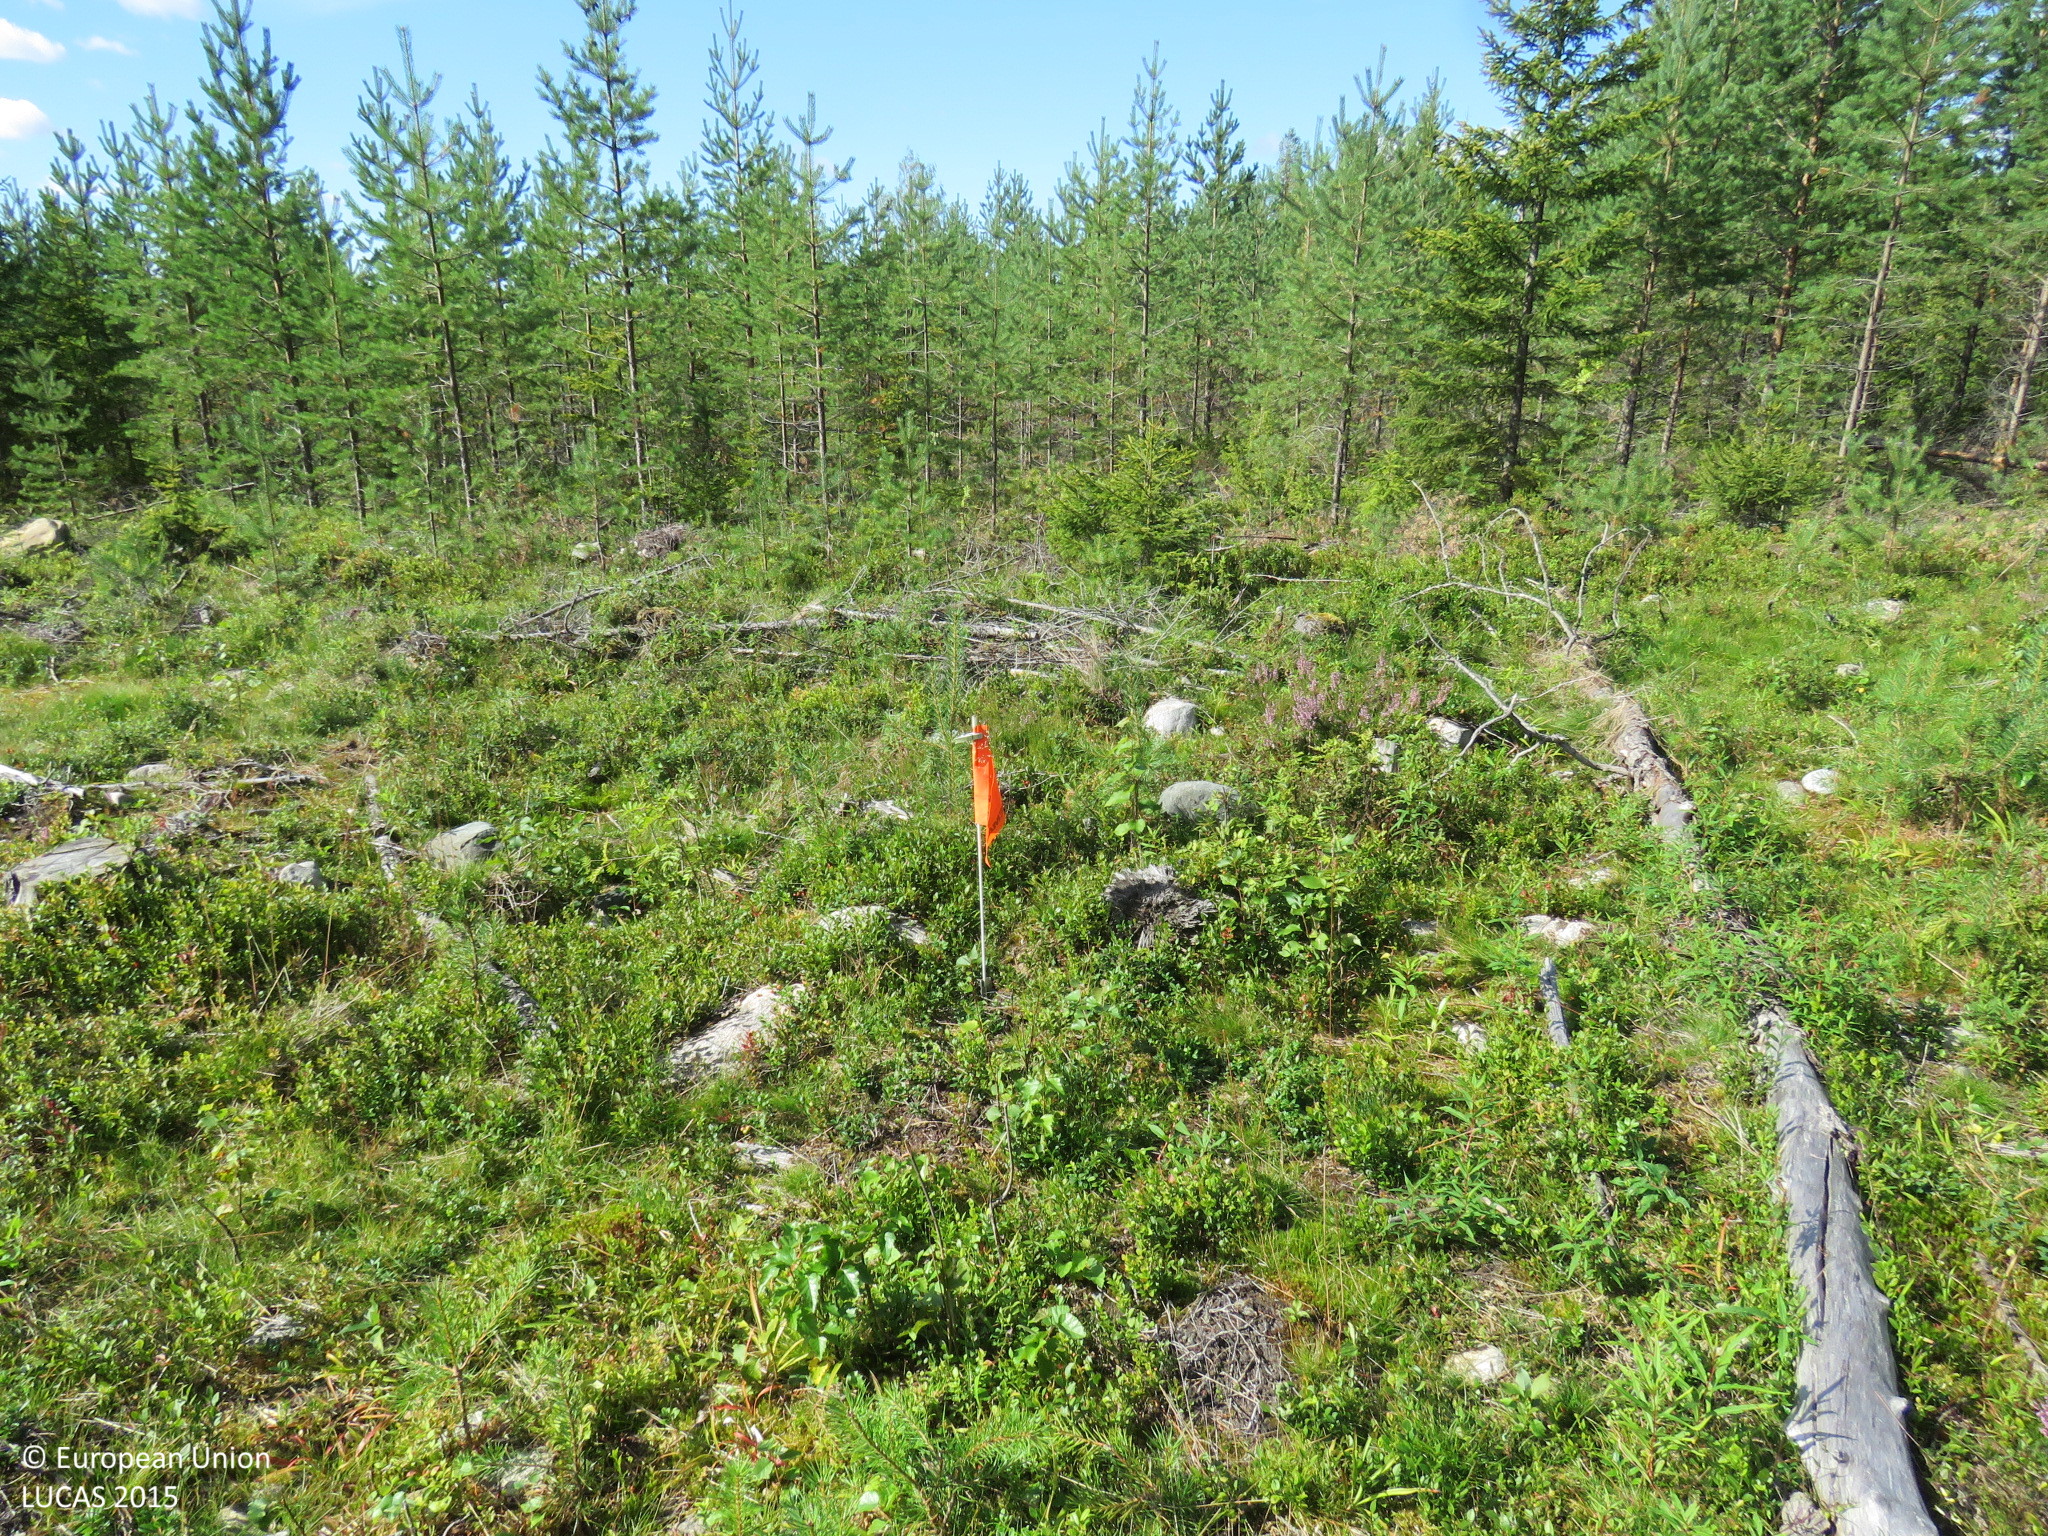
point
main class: Woodland
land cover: Other mixed woodland
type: boreal forest
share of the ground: 25 - 50 %
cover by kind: shrubs 40 %, coniferous forest trees 20 %, herbaceous plants 20 %, broadleaved forest trees 10 %, unconsolidated bare surface 10 %
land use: Forestry
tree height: < 5 m
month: August
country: FI
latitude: 65.2245
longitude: 26.0259
